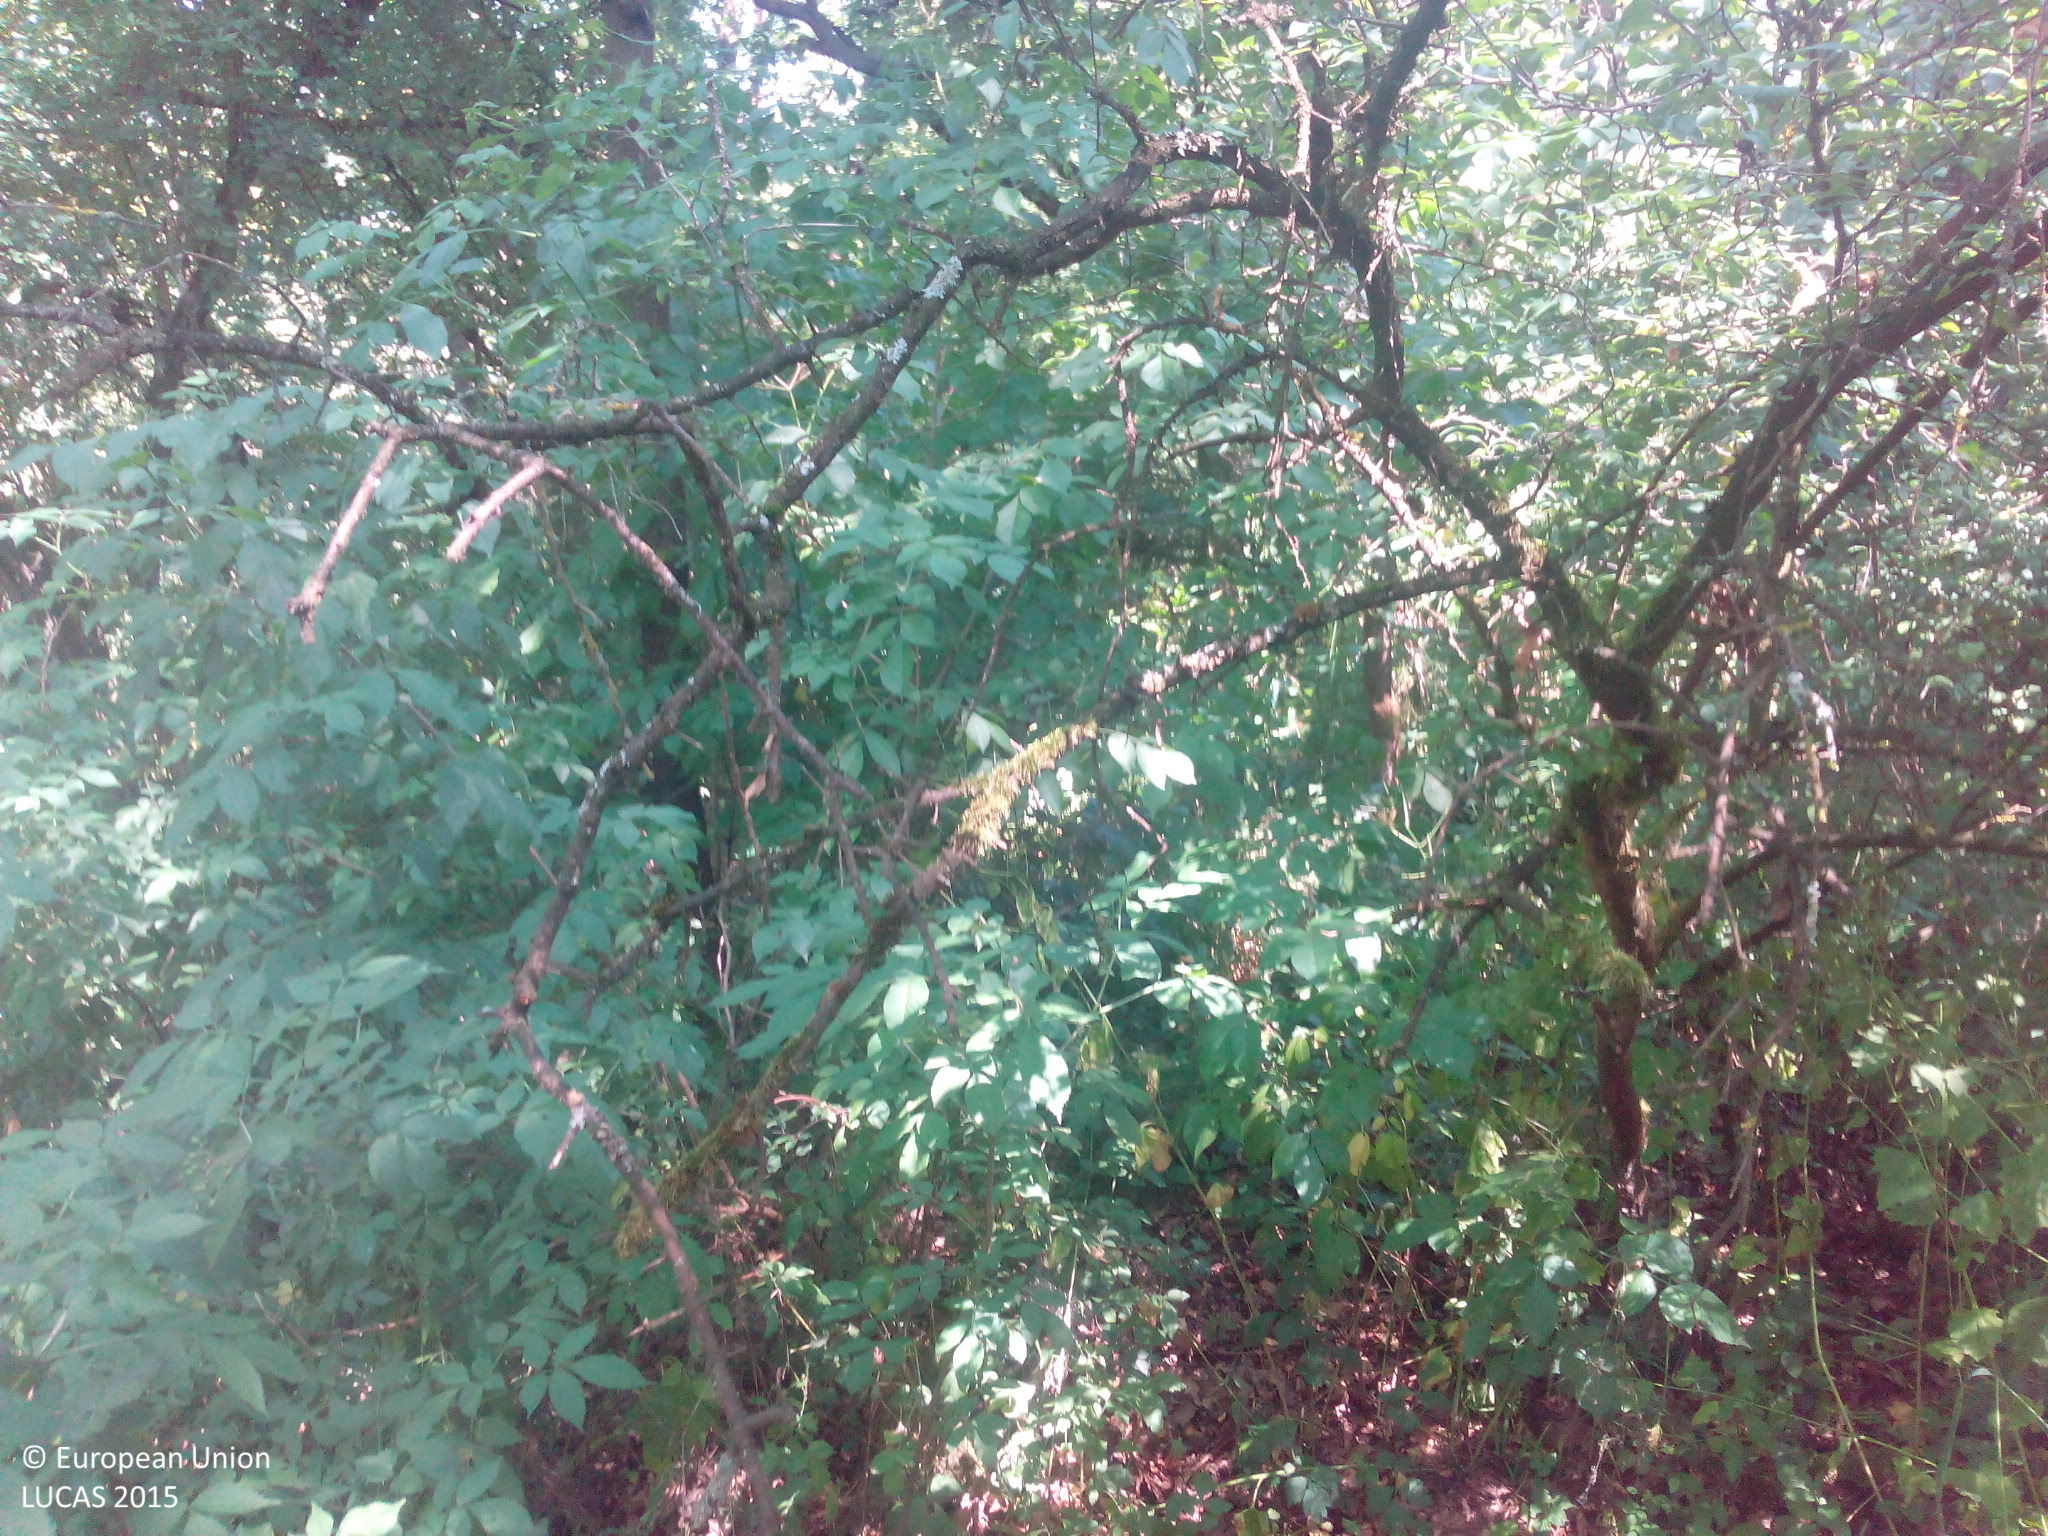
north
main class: Woodland
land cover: Broadleaved woodland
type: mesophytic deciduous forest
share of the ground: > 75 %
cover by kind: broadleaved forest trees 90 %, herbaceous plants 10 %
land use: Semi-natural and natural areas not in use
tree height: > 5 m
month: July
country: DE
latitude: 50.1285
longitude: 10.6293
